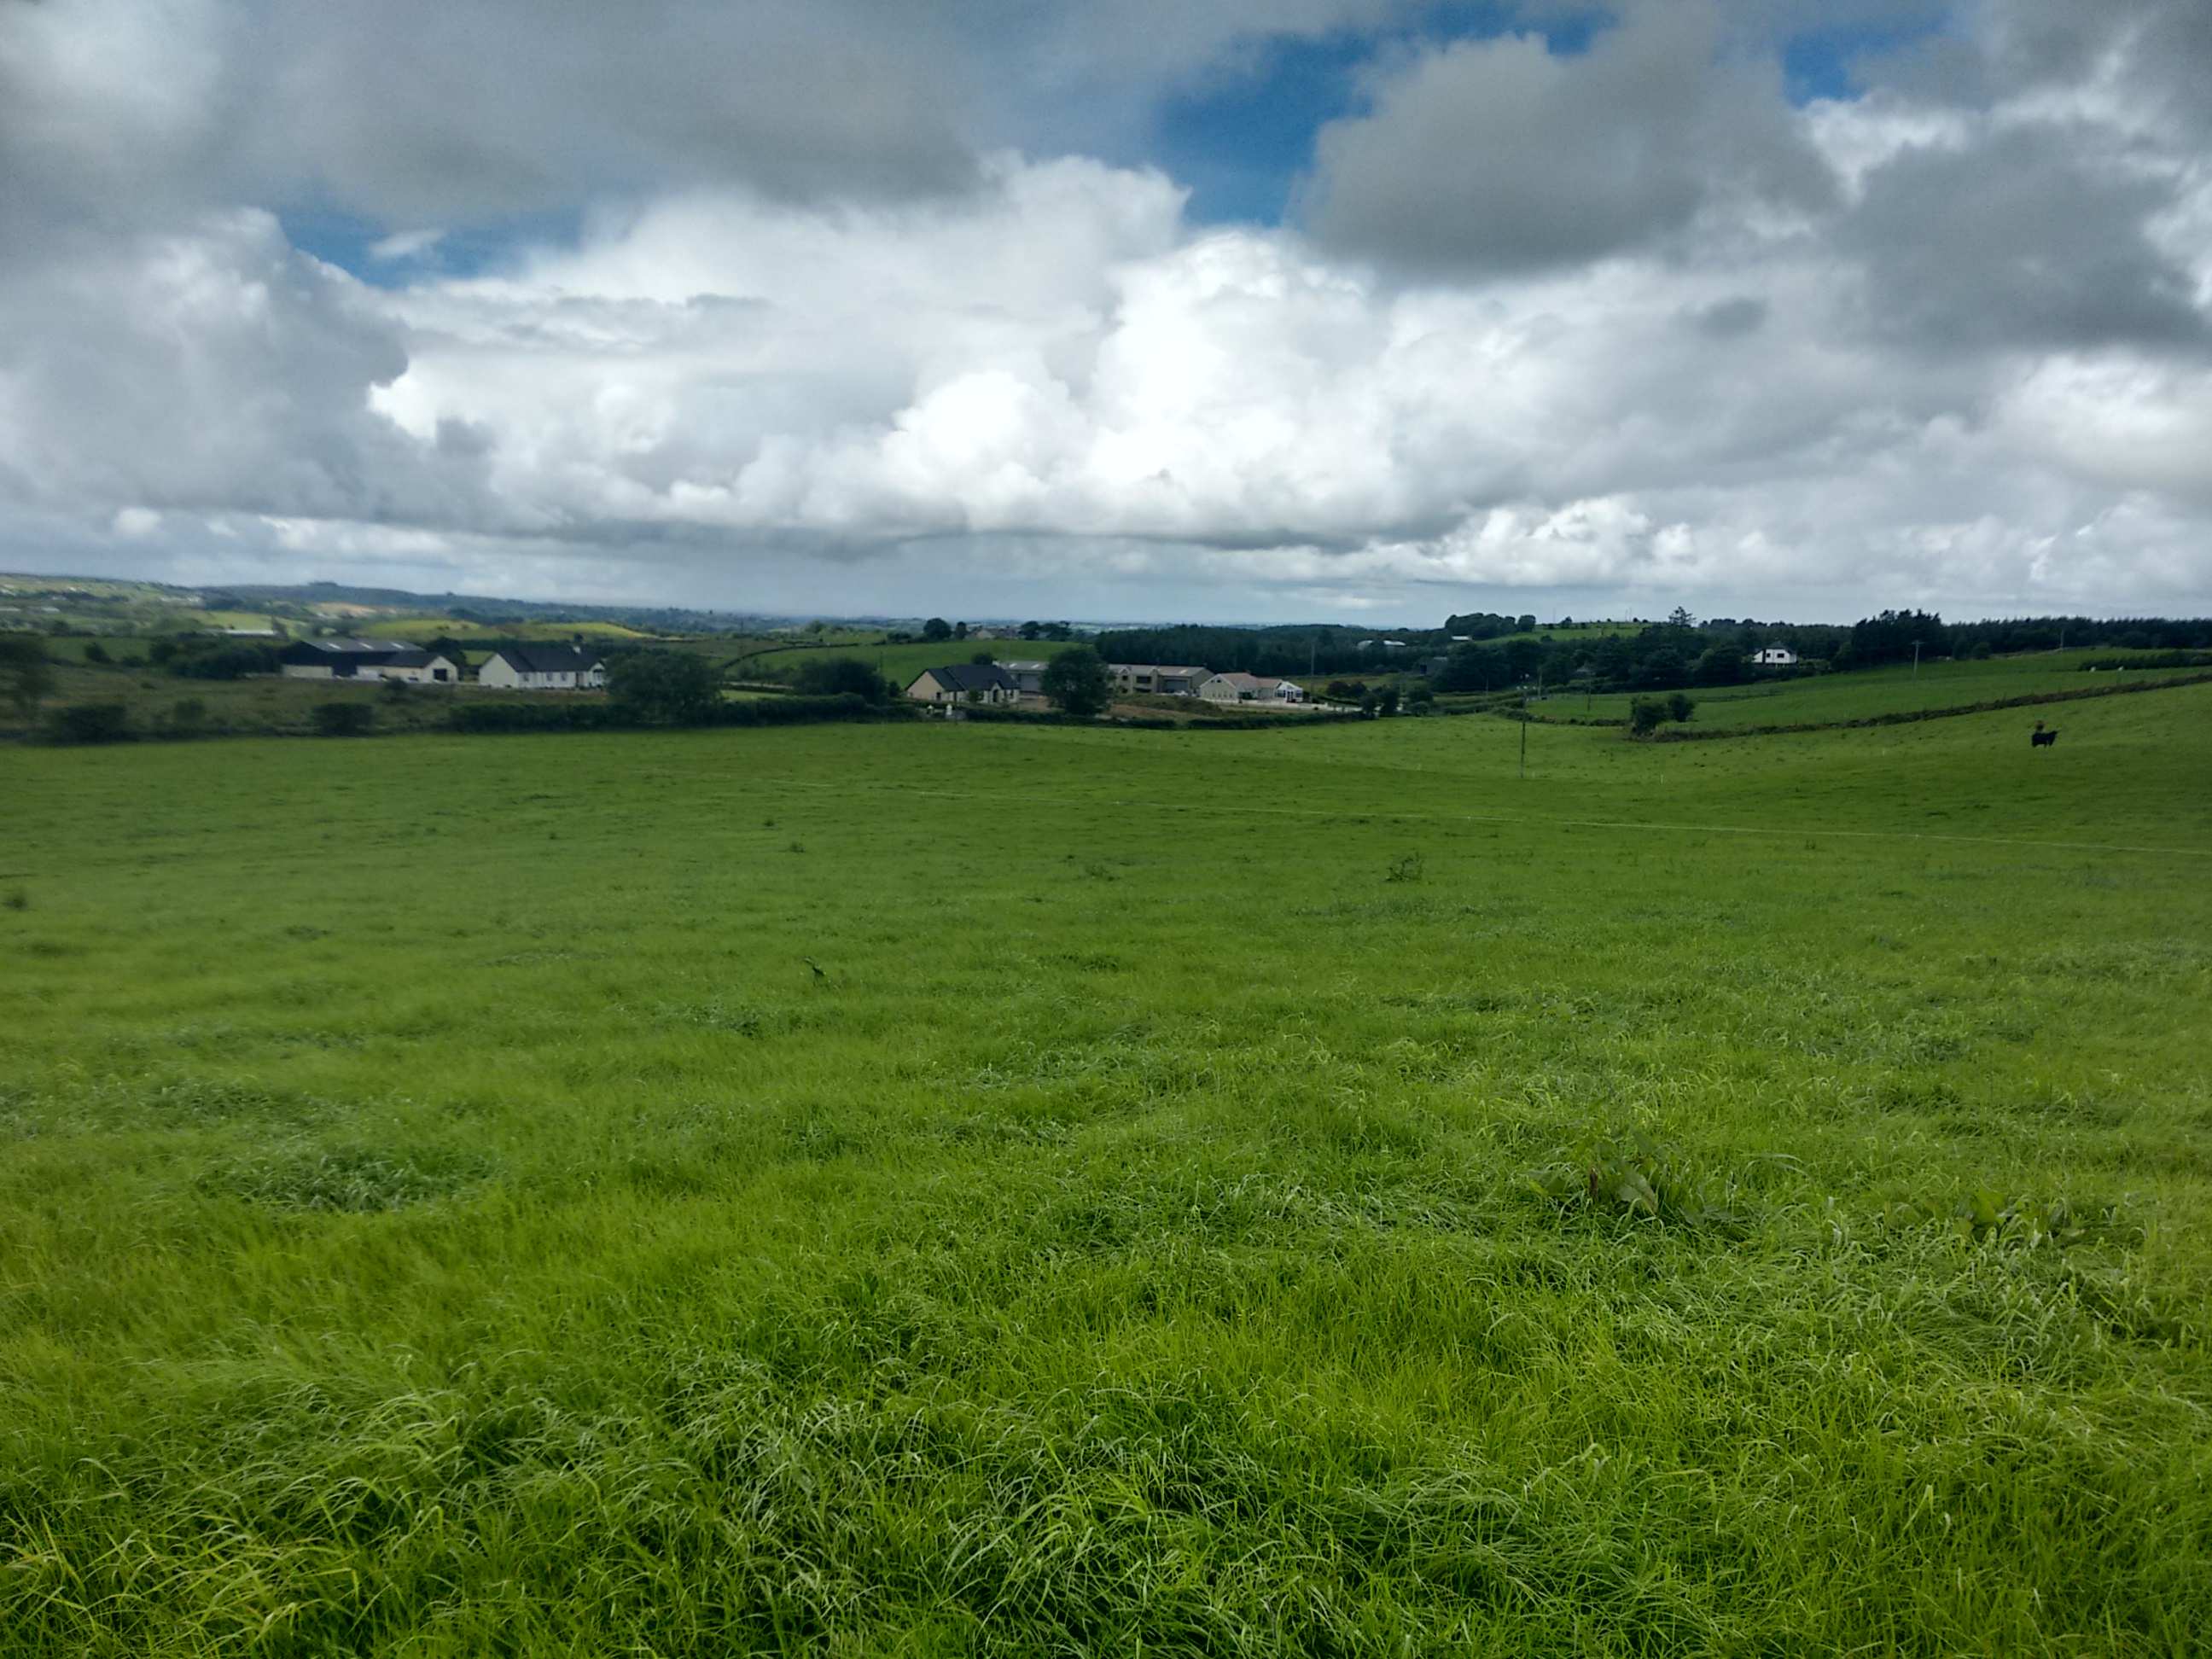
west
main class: Grassland
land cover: Grassland without tree/shrub cover
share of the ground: > 75 %
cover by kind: herbaceous plants 100 %
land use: Agriculture (excluding fallow land and kitchen gardens)
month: July
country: GB
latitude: 54.5989
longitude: -6.9956
